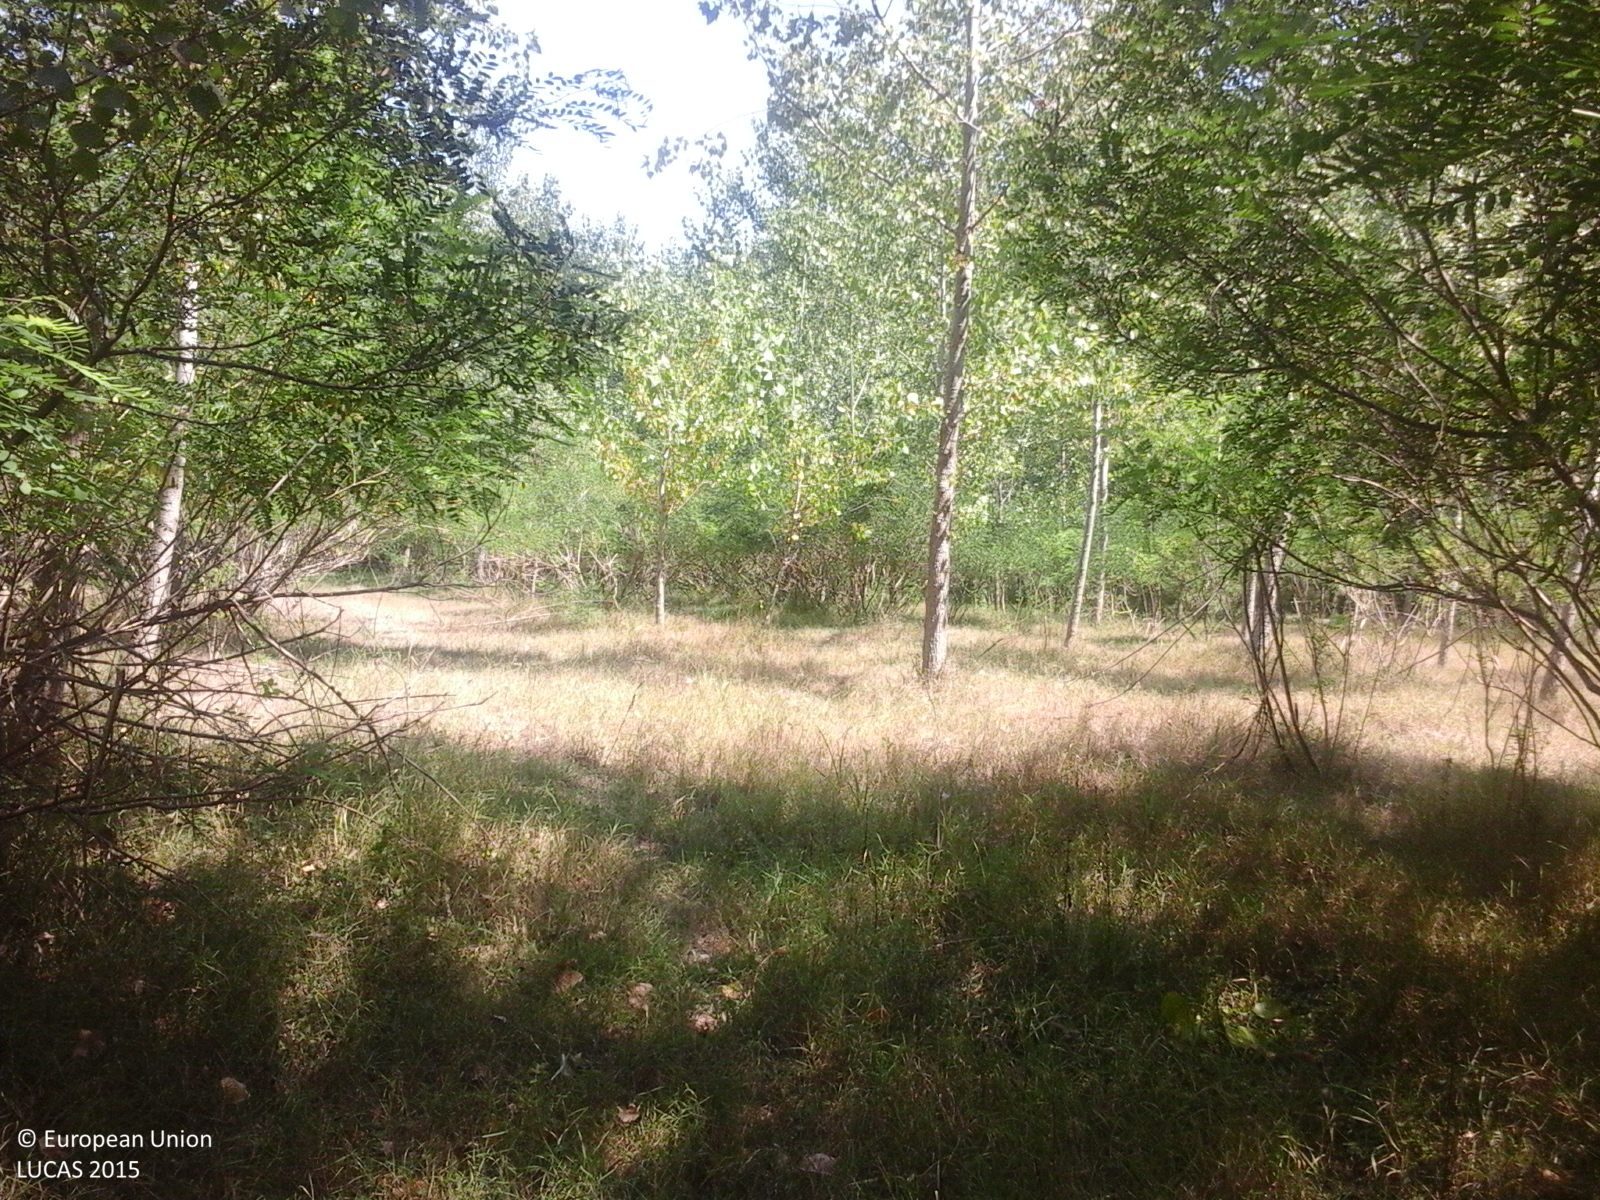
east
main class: Woodland
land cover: Broadleaved woodland
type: floodplain forest
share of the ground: > 75 %
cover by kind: broadleaved forest trees 80 %, herbaceous plants 20 %
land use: Forestry
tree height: > 5 m
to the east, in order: Broadleaved woodland; Tracks; Broadleaved woodland
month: July
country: RO
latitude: 44.1294
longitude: 27.4470
